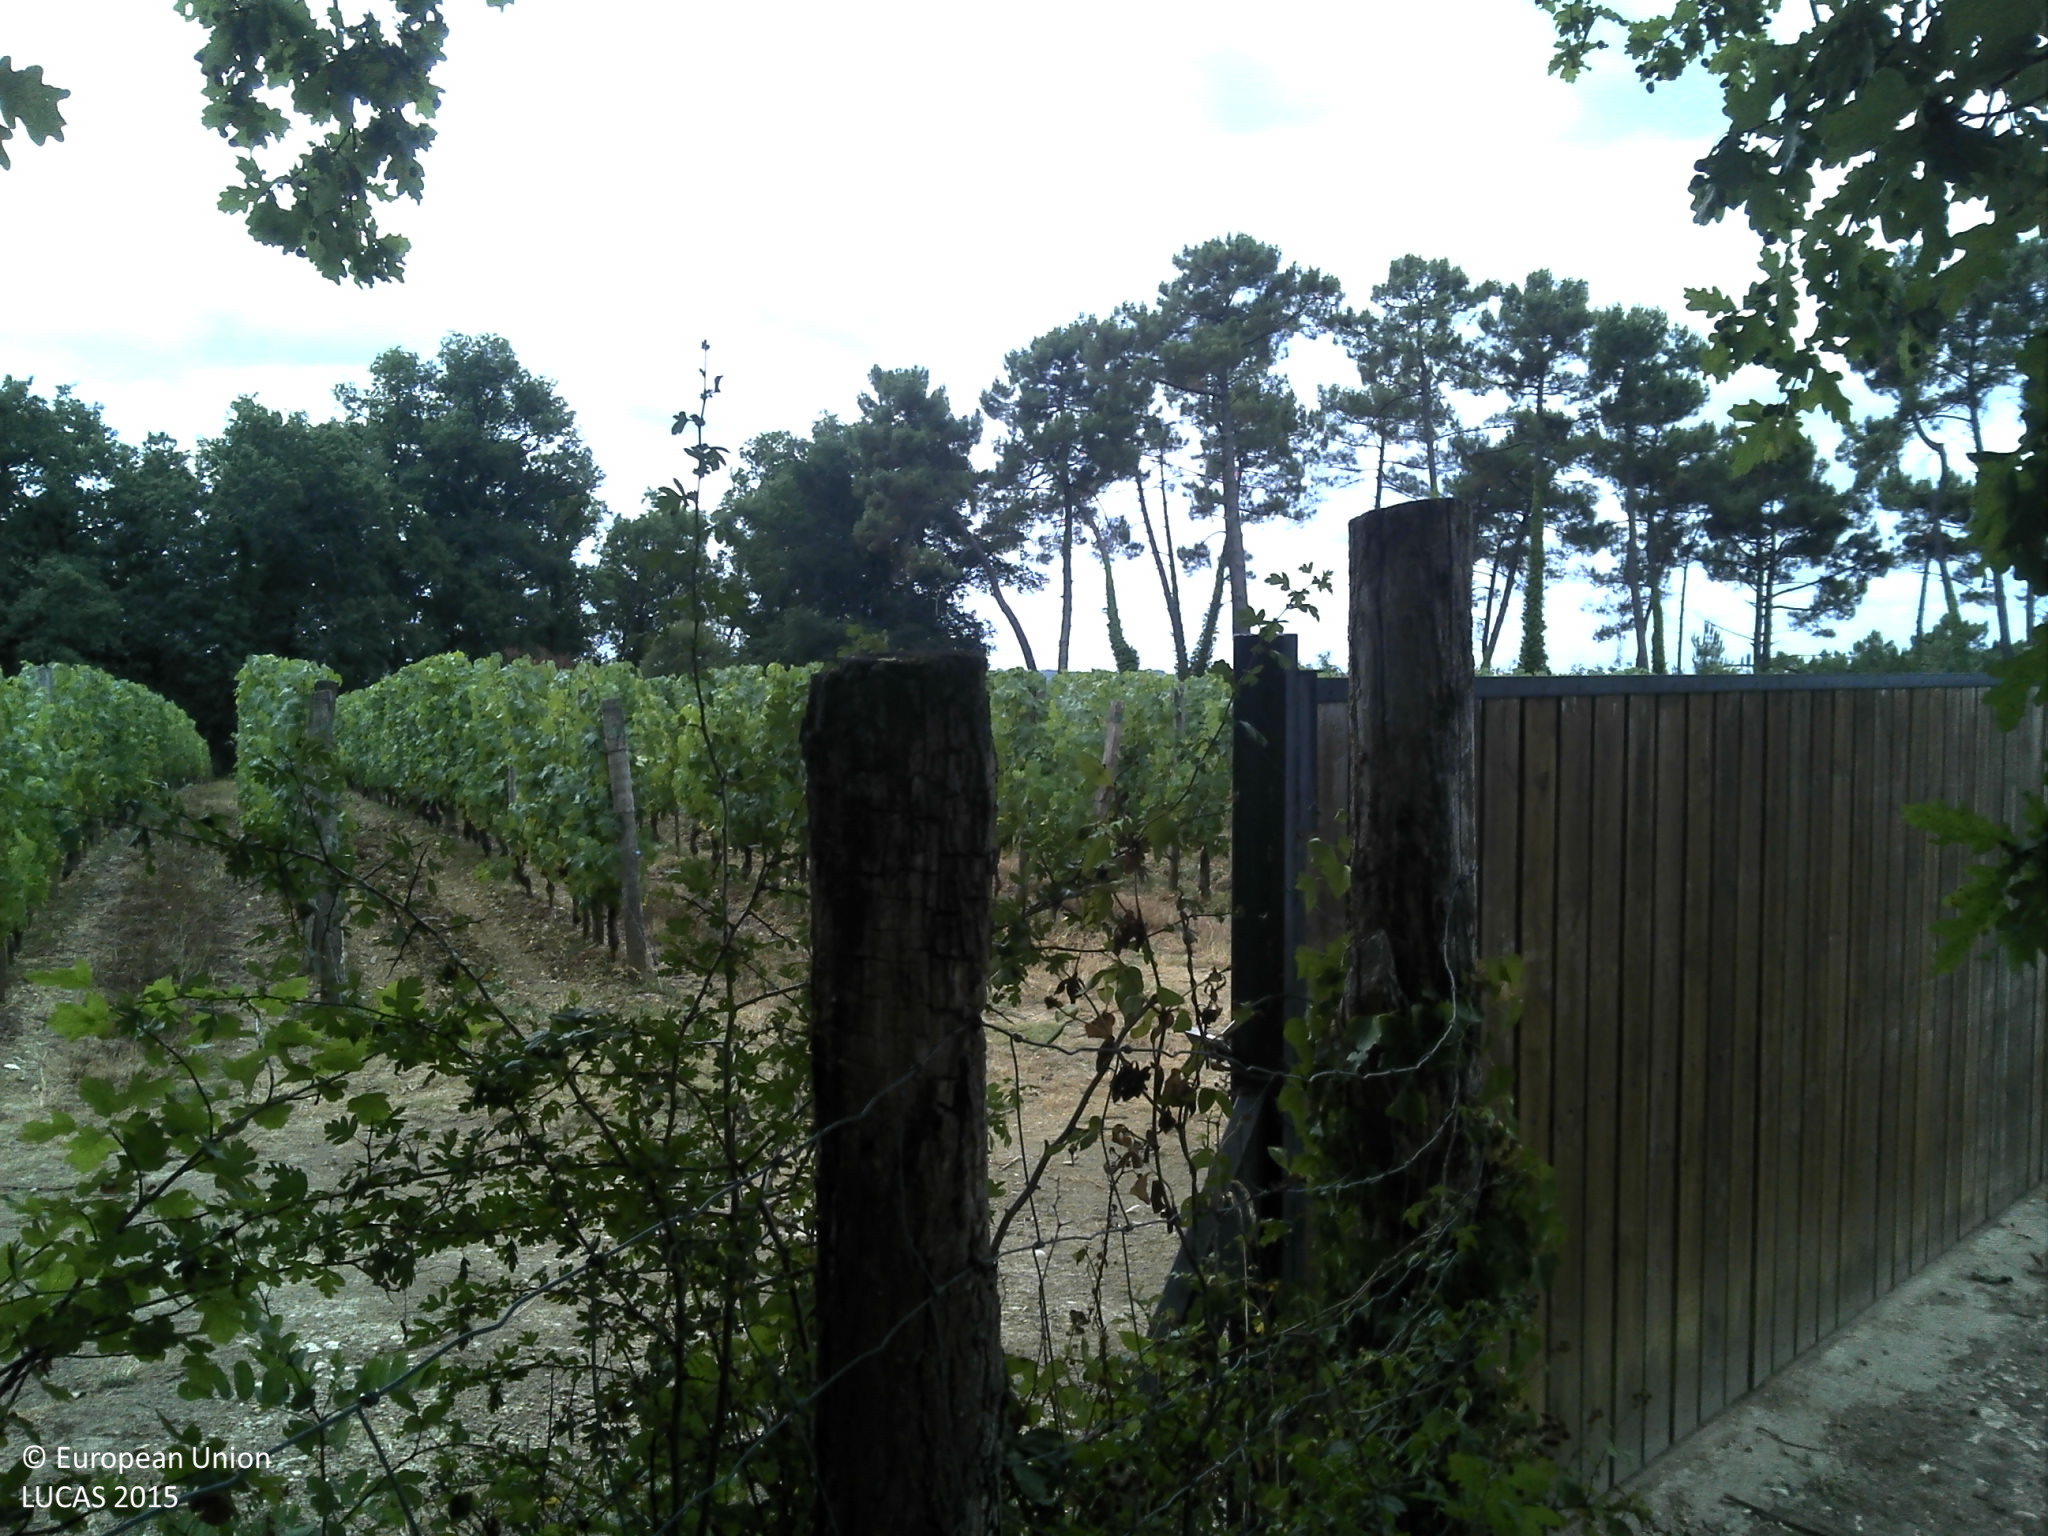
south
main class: Woodland
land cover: Broadleaved woodland
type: thermophilous deciduous forest
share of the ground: > 75 %
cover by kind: broadleaved forest trees 100 %
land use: Forestry
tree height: > 5 m
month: July
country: FR
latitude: 44.8055
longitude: -0.4222
